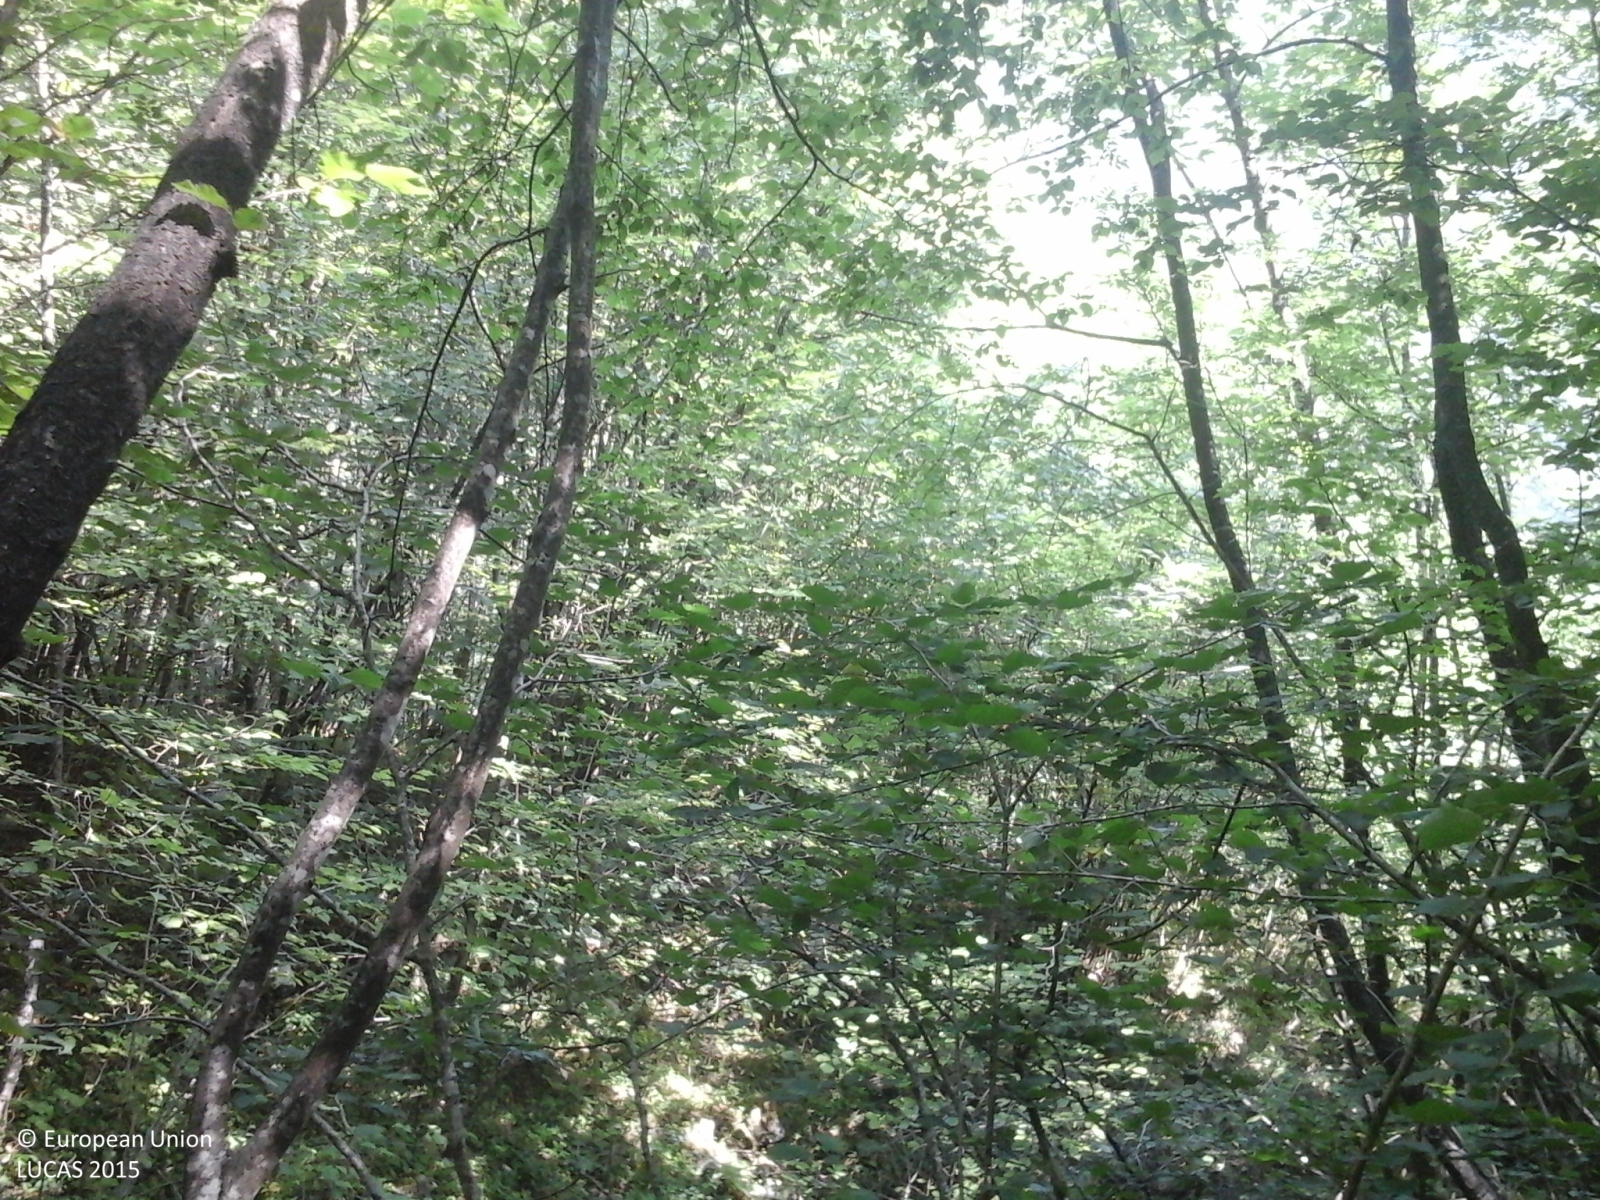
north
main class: Woodland
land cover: Broadleaved woodland
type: thermophilous deciduous forest
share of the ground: > 75 %
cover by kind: broadleaved forest trees 100 %
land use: Forestry
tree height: > 5 m
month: July
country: IT
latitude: 45.8822
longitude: 9.6269
